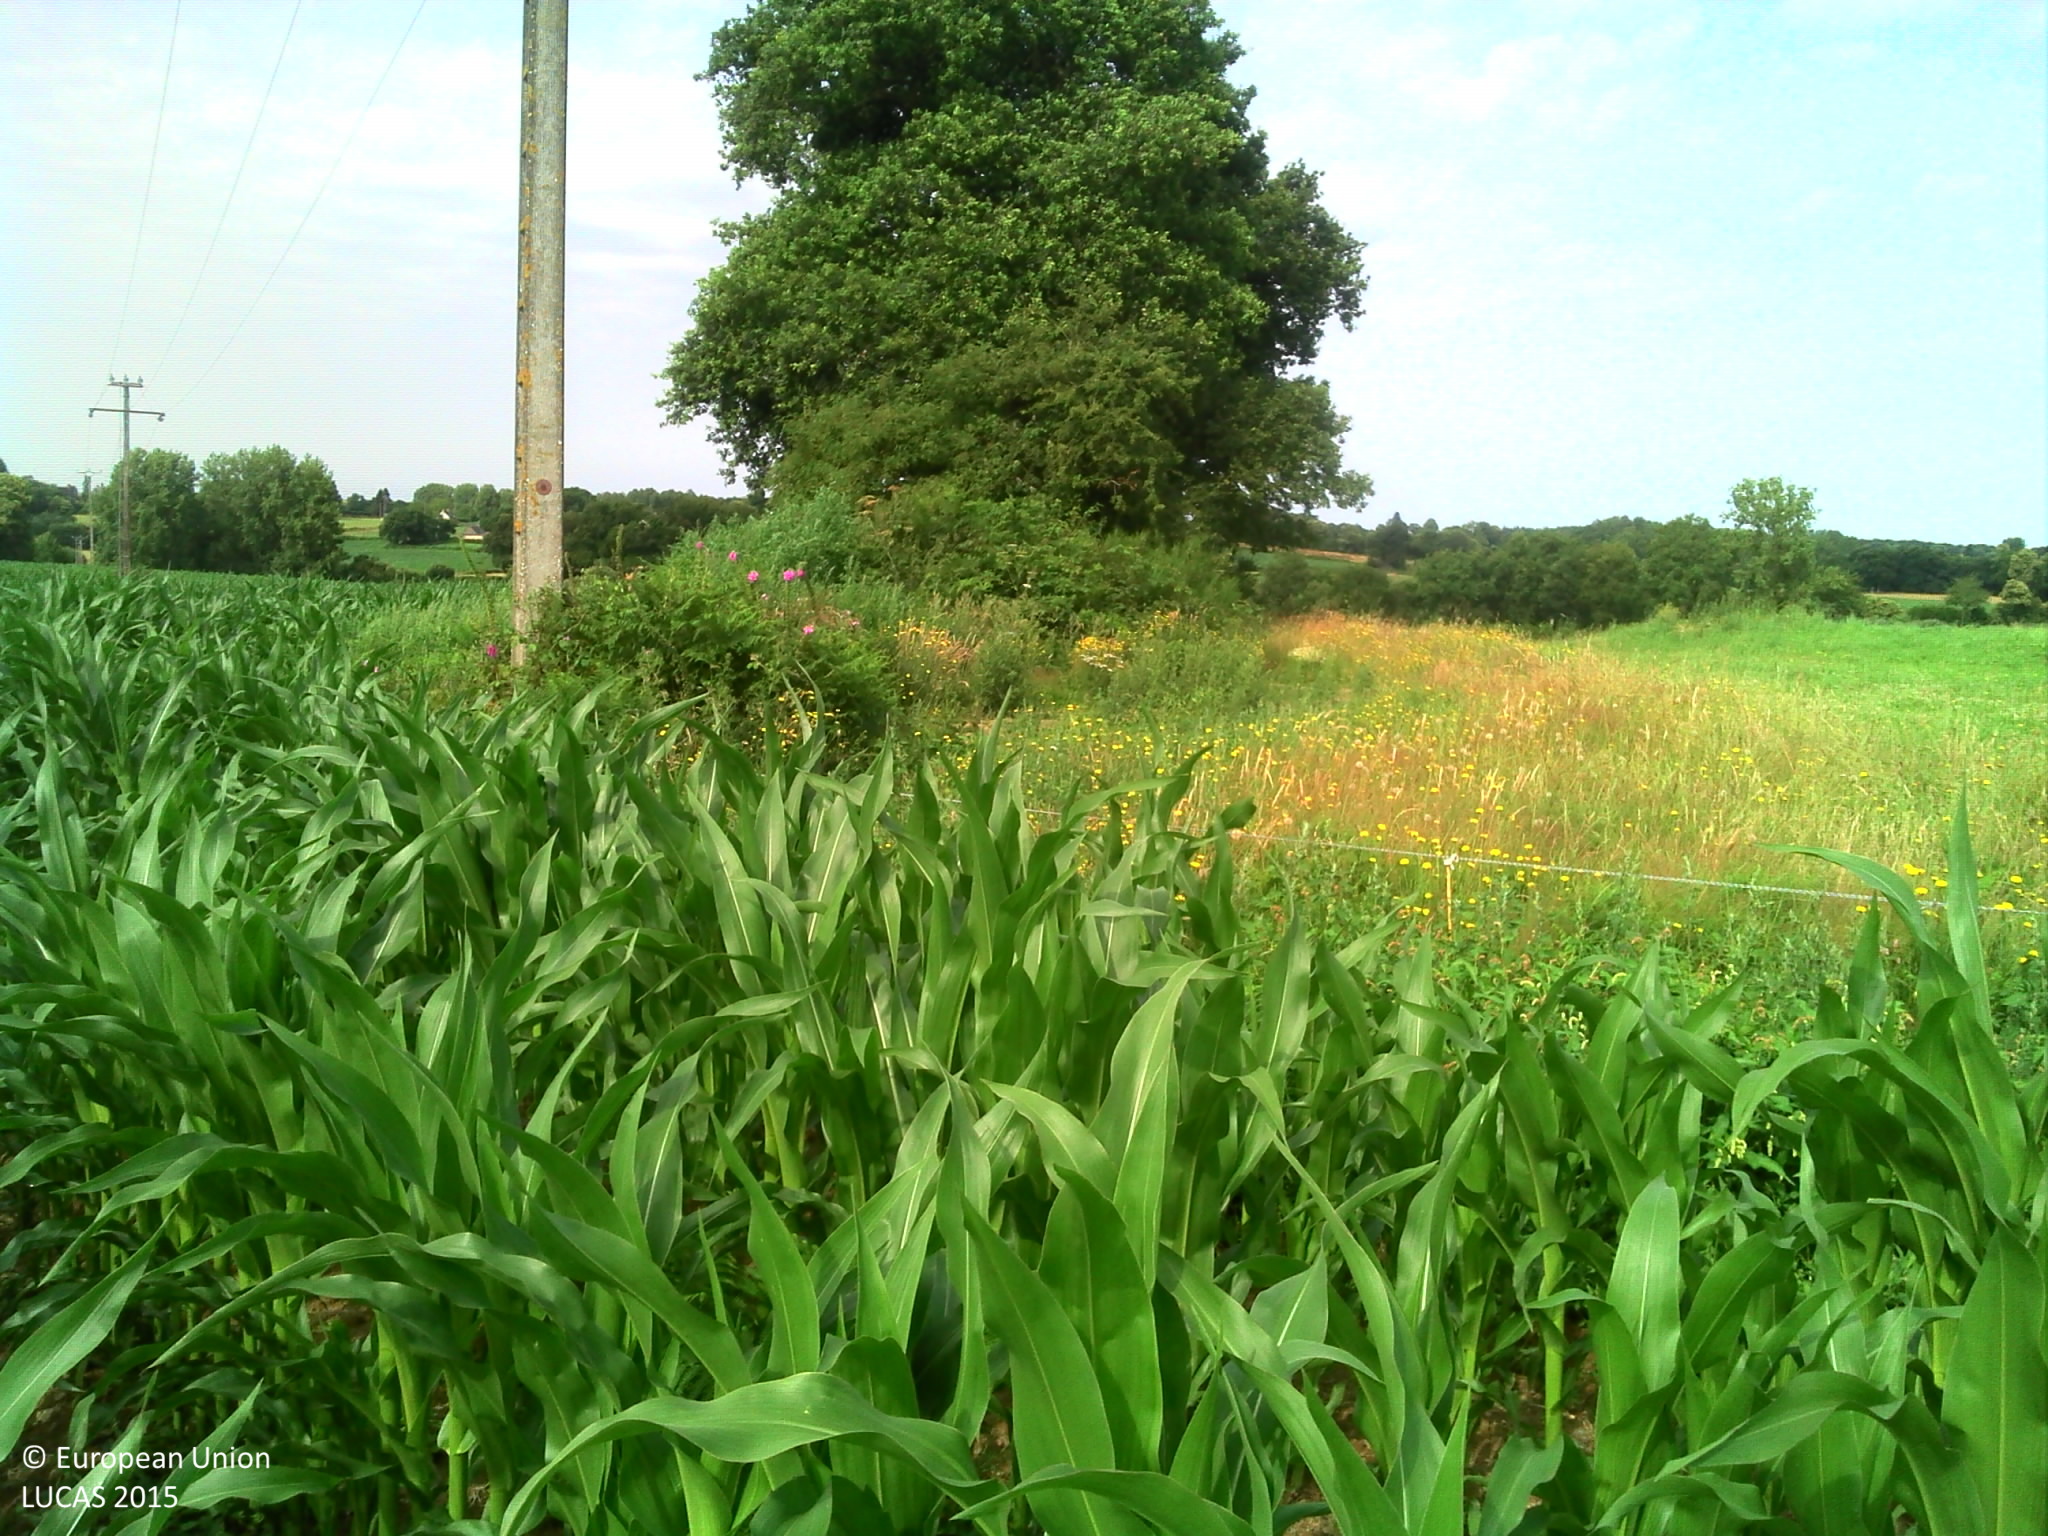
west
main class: Cropland
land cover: Maize
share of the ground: > 75 %
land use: Agriculture (excluding fallow land and kitchen gardens)
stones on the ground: 10 - 25 %
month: July
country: FR
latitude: 48.4732
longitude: -1.5040
